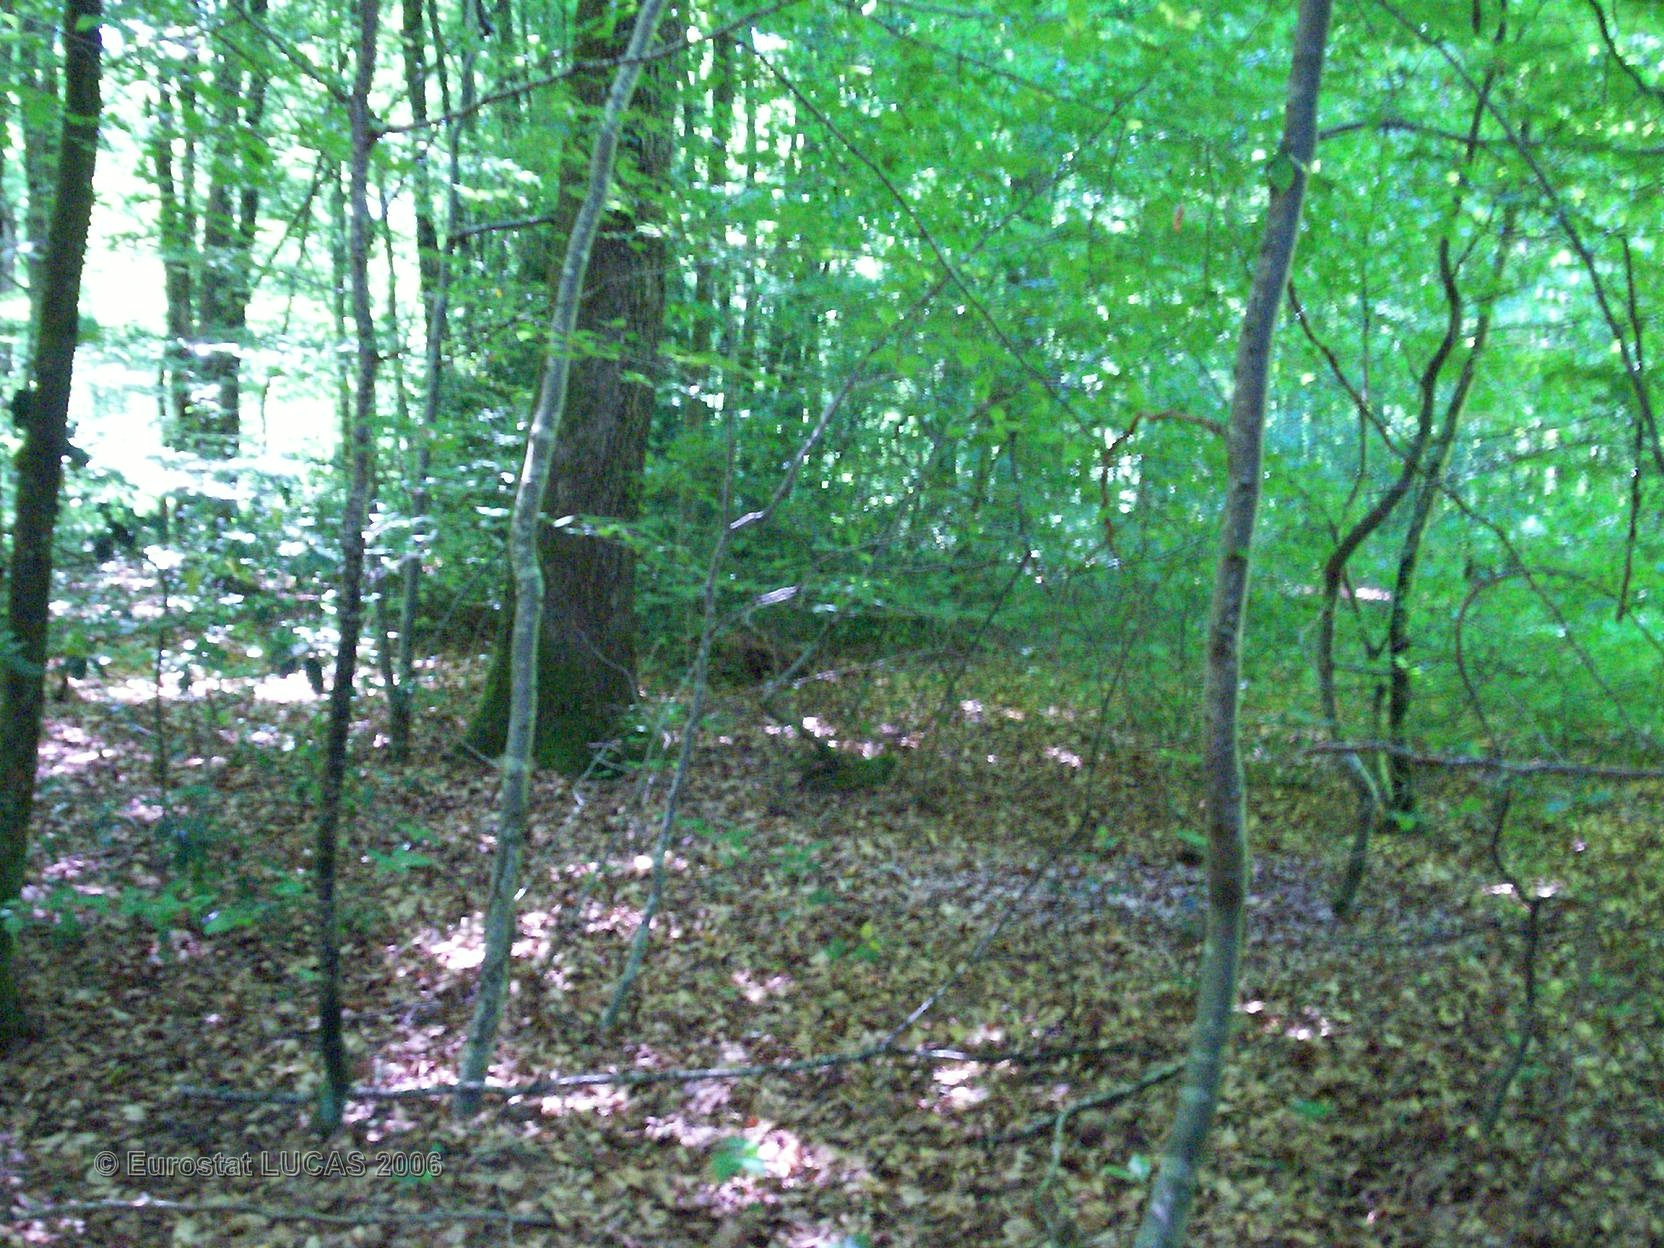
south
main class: Woodland
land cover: Broadleaved forest
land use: Forestry
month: June
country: FR
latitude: 47.4126
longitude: 6.0122
